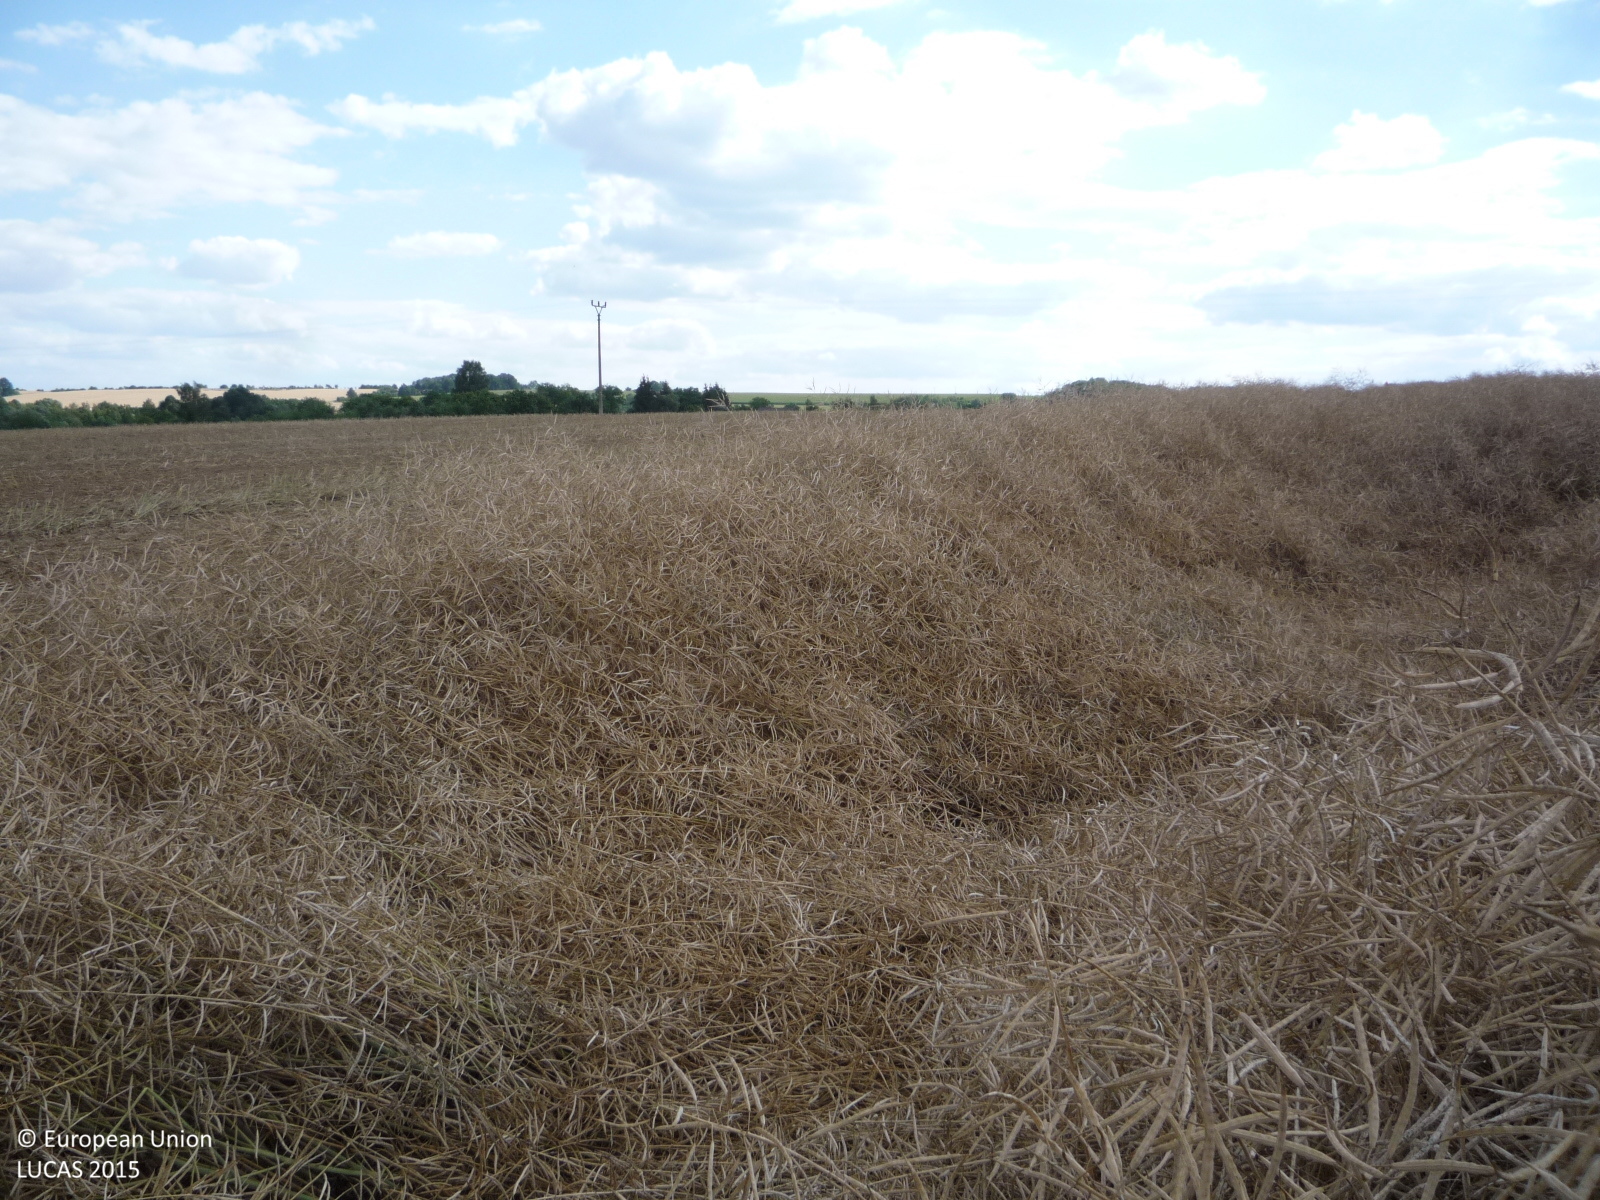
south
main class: Cropland
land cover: Rape and turnip rape
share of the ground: > 75 %
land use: Agriculture (excluding fallow land and kitchen gardens)
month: July
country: CZ
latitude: 50.4607
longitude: 15.2295
